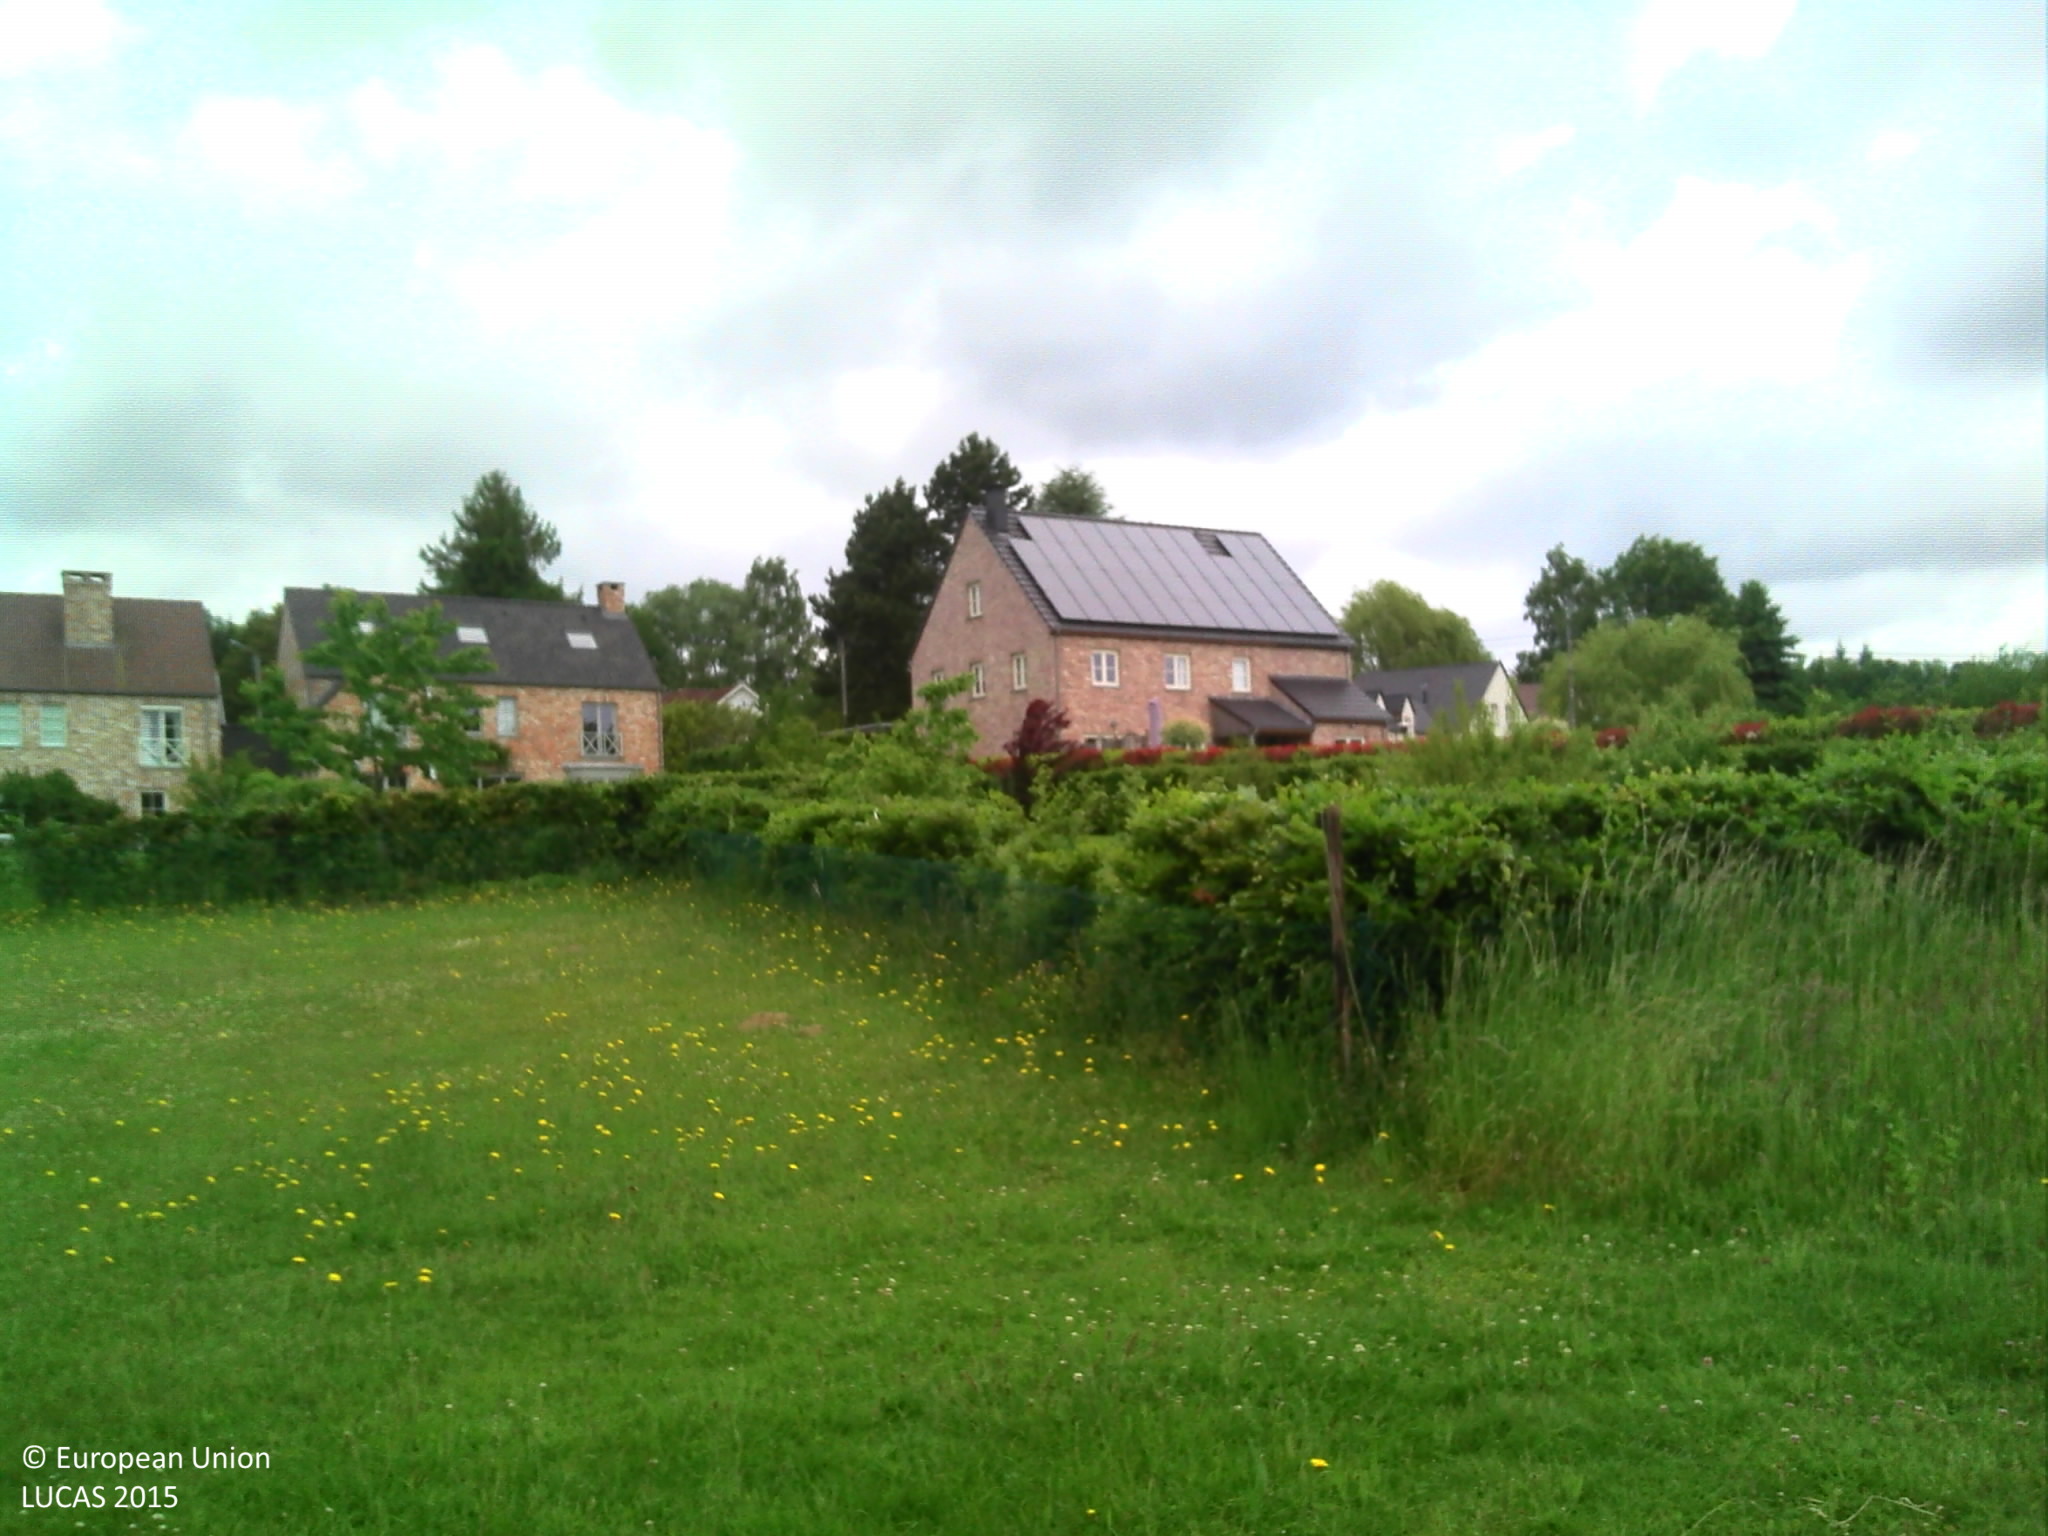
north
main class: Grassland
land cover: Grassland without tree/shrub cover
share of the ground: > 75 %
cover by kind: herbaceous plants 100 %
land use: Agriculture (excluding fallow land and kitchen gardens)
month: May
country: BE
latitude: 50.7011
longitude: 4.5164
